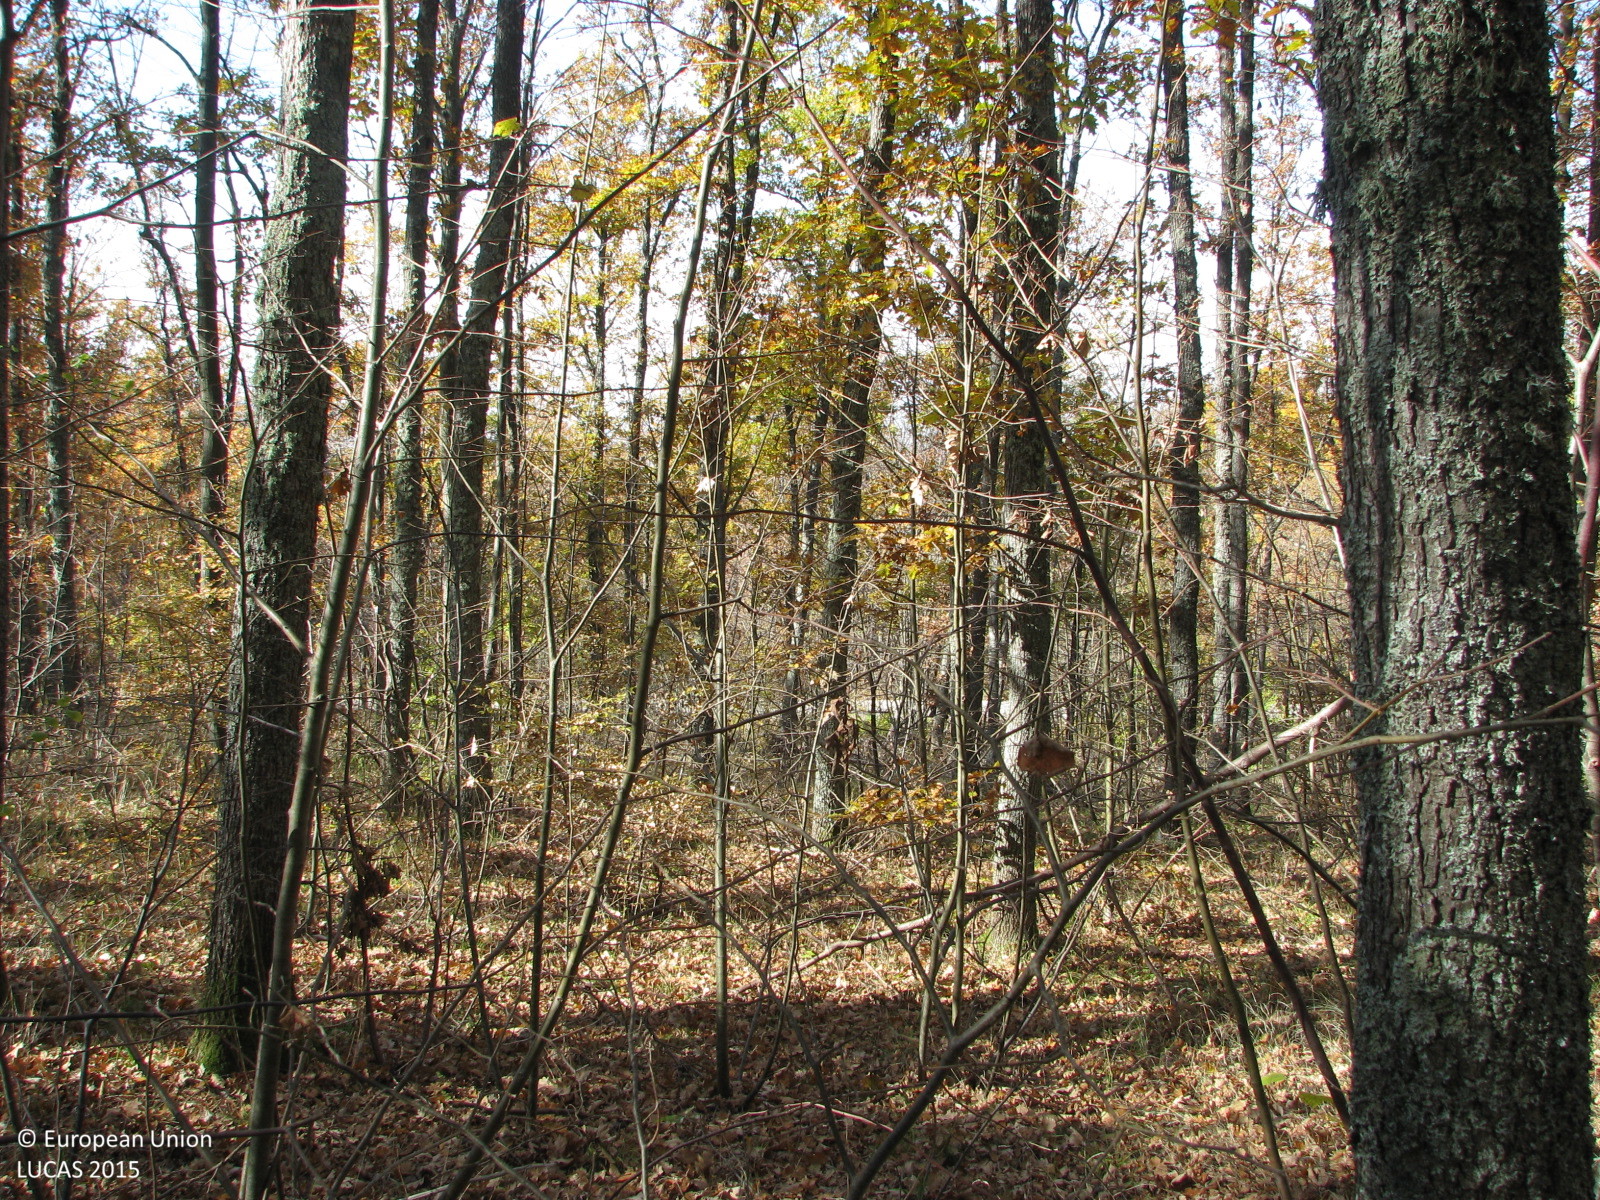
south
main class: Woodland
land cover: Broadleaved woodland
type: mesophytic deciduous forest
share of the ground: 50 - 75 %
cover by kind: broadleaved forest trees 65 %, herbaceous plants 25 %, shrubs 10 %
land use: Forestry
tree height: > 5 m
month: November
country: BG
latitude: 42.0316
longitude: 26.3528
